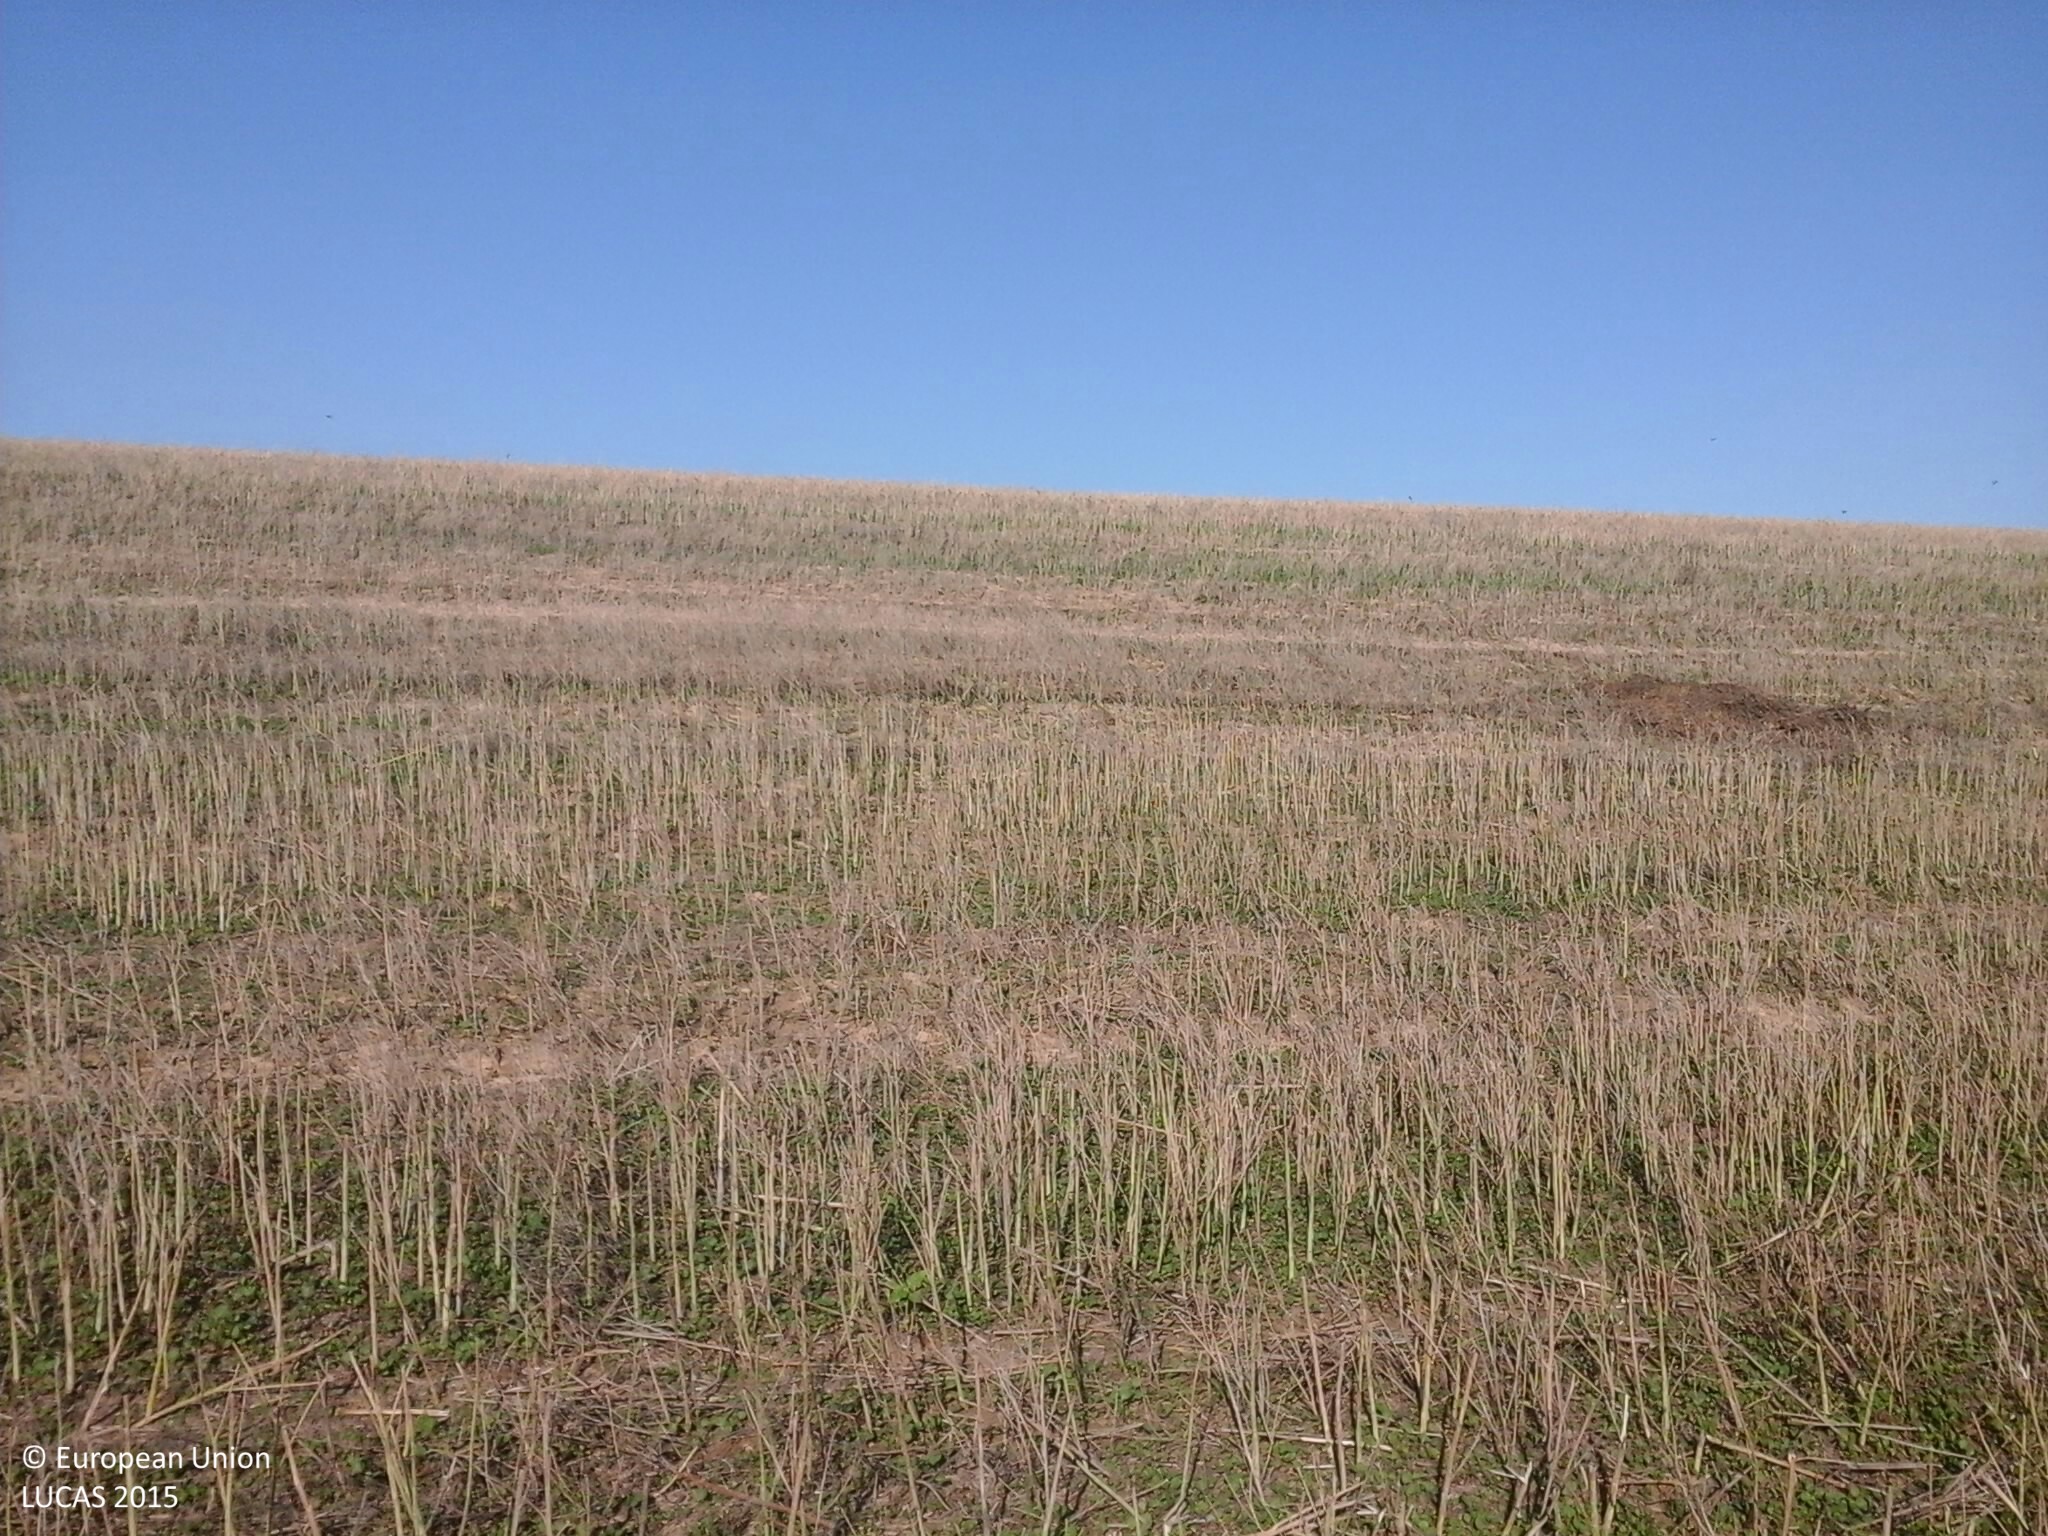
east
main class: Shrubland
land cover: Shrubland with sparse tree cover
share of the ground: > 75 %
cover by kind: shrubs 95 %, broadleaved forest trees 5 %
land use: Semi-natural and natural areas not in use
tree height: < 5 m
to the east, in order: Shrubland with sparse tree cover; Spontaneously vegetated surfaces; Rape and turnip rape
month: July
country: HU
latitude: 46.5965
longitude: 17.7208
